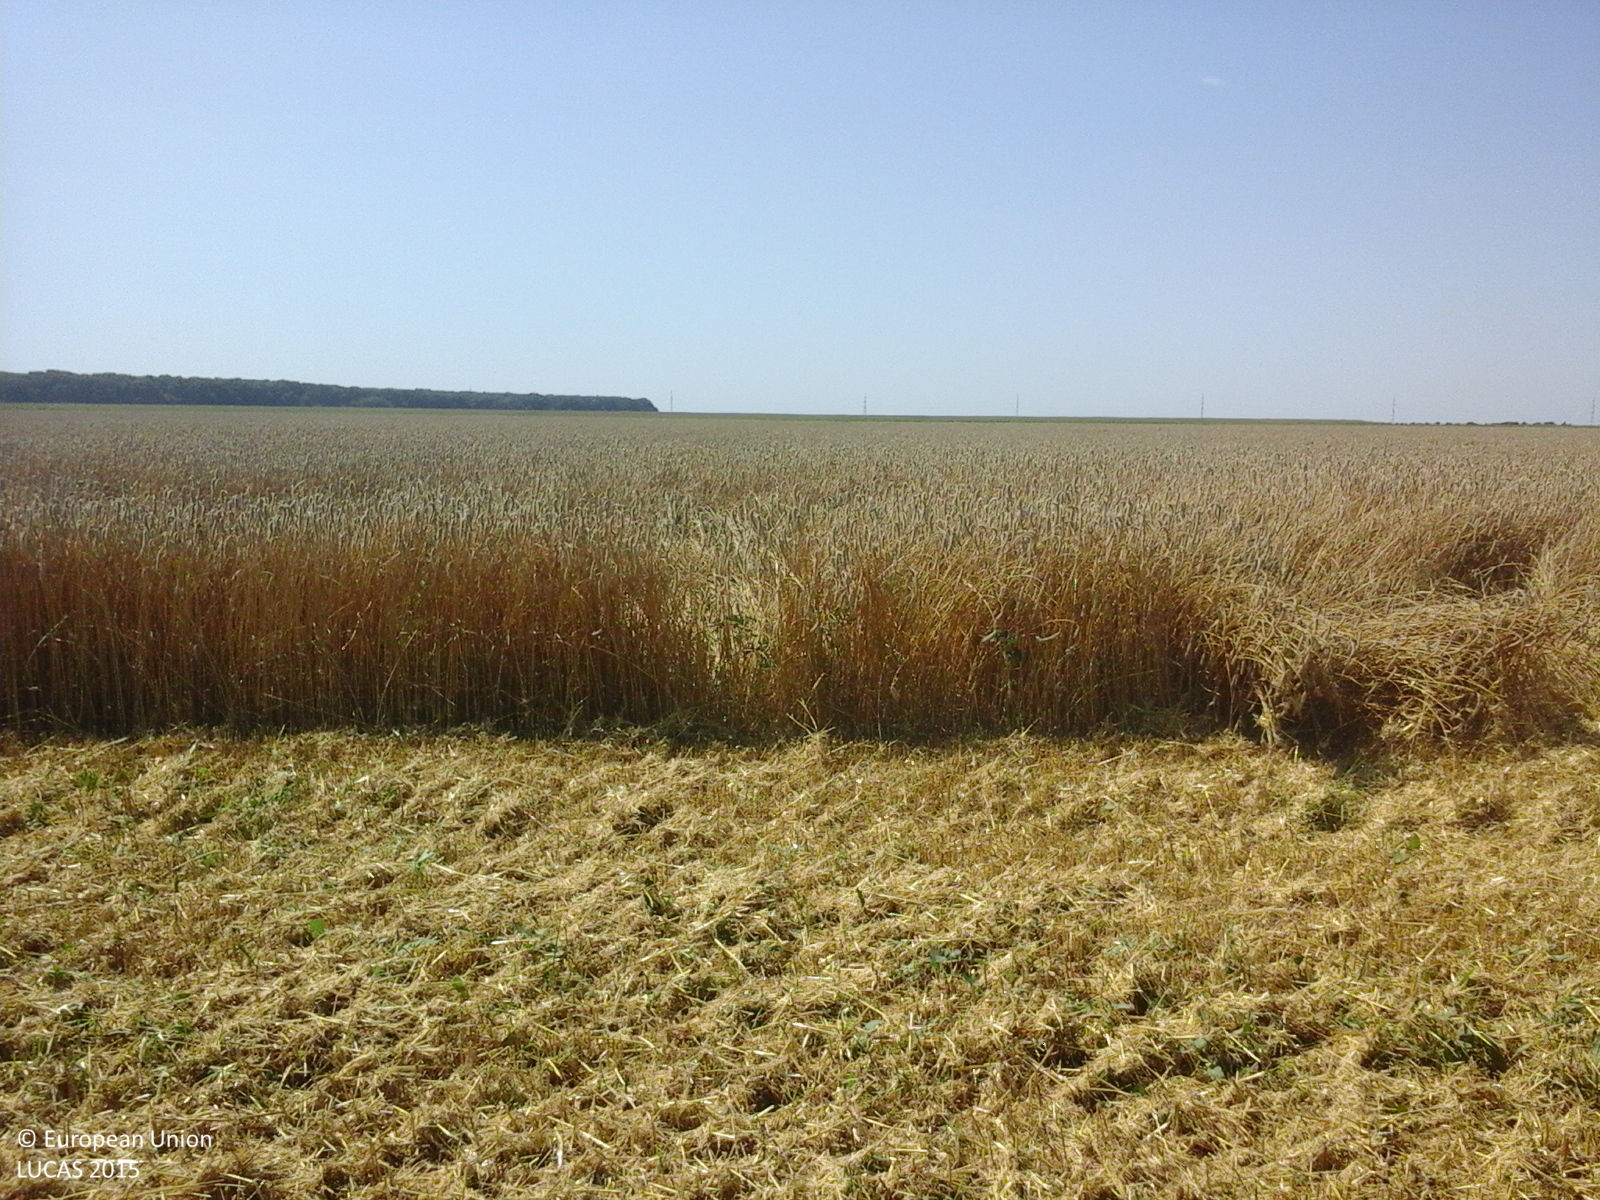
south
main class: Cropland
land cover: Common wheat
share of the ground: > 75 %
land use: Agriculture (excluding fallow land and kitchen gardens)
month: July
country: RO
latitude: 44.4187
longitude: 26.4794
